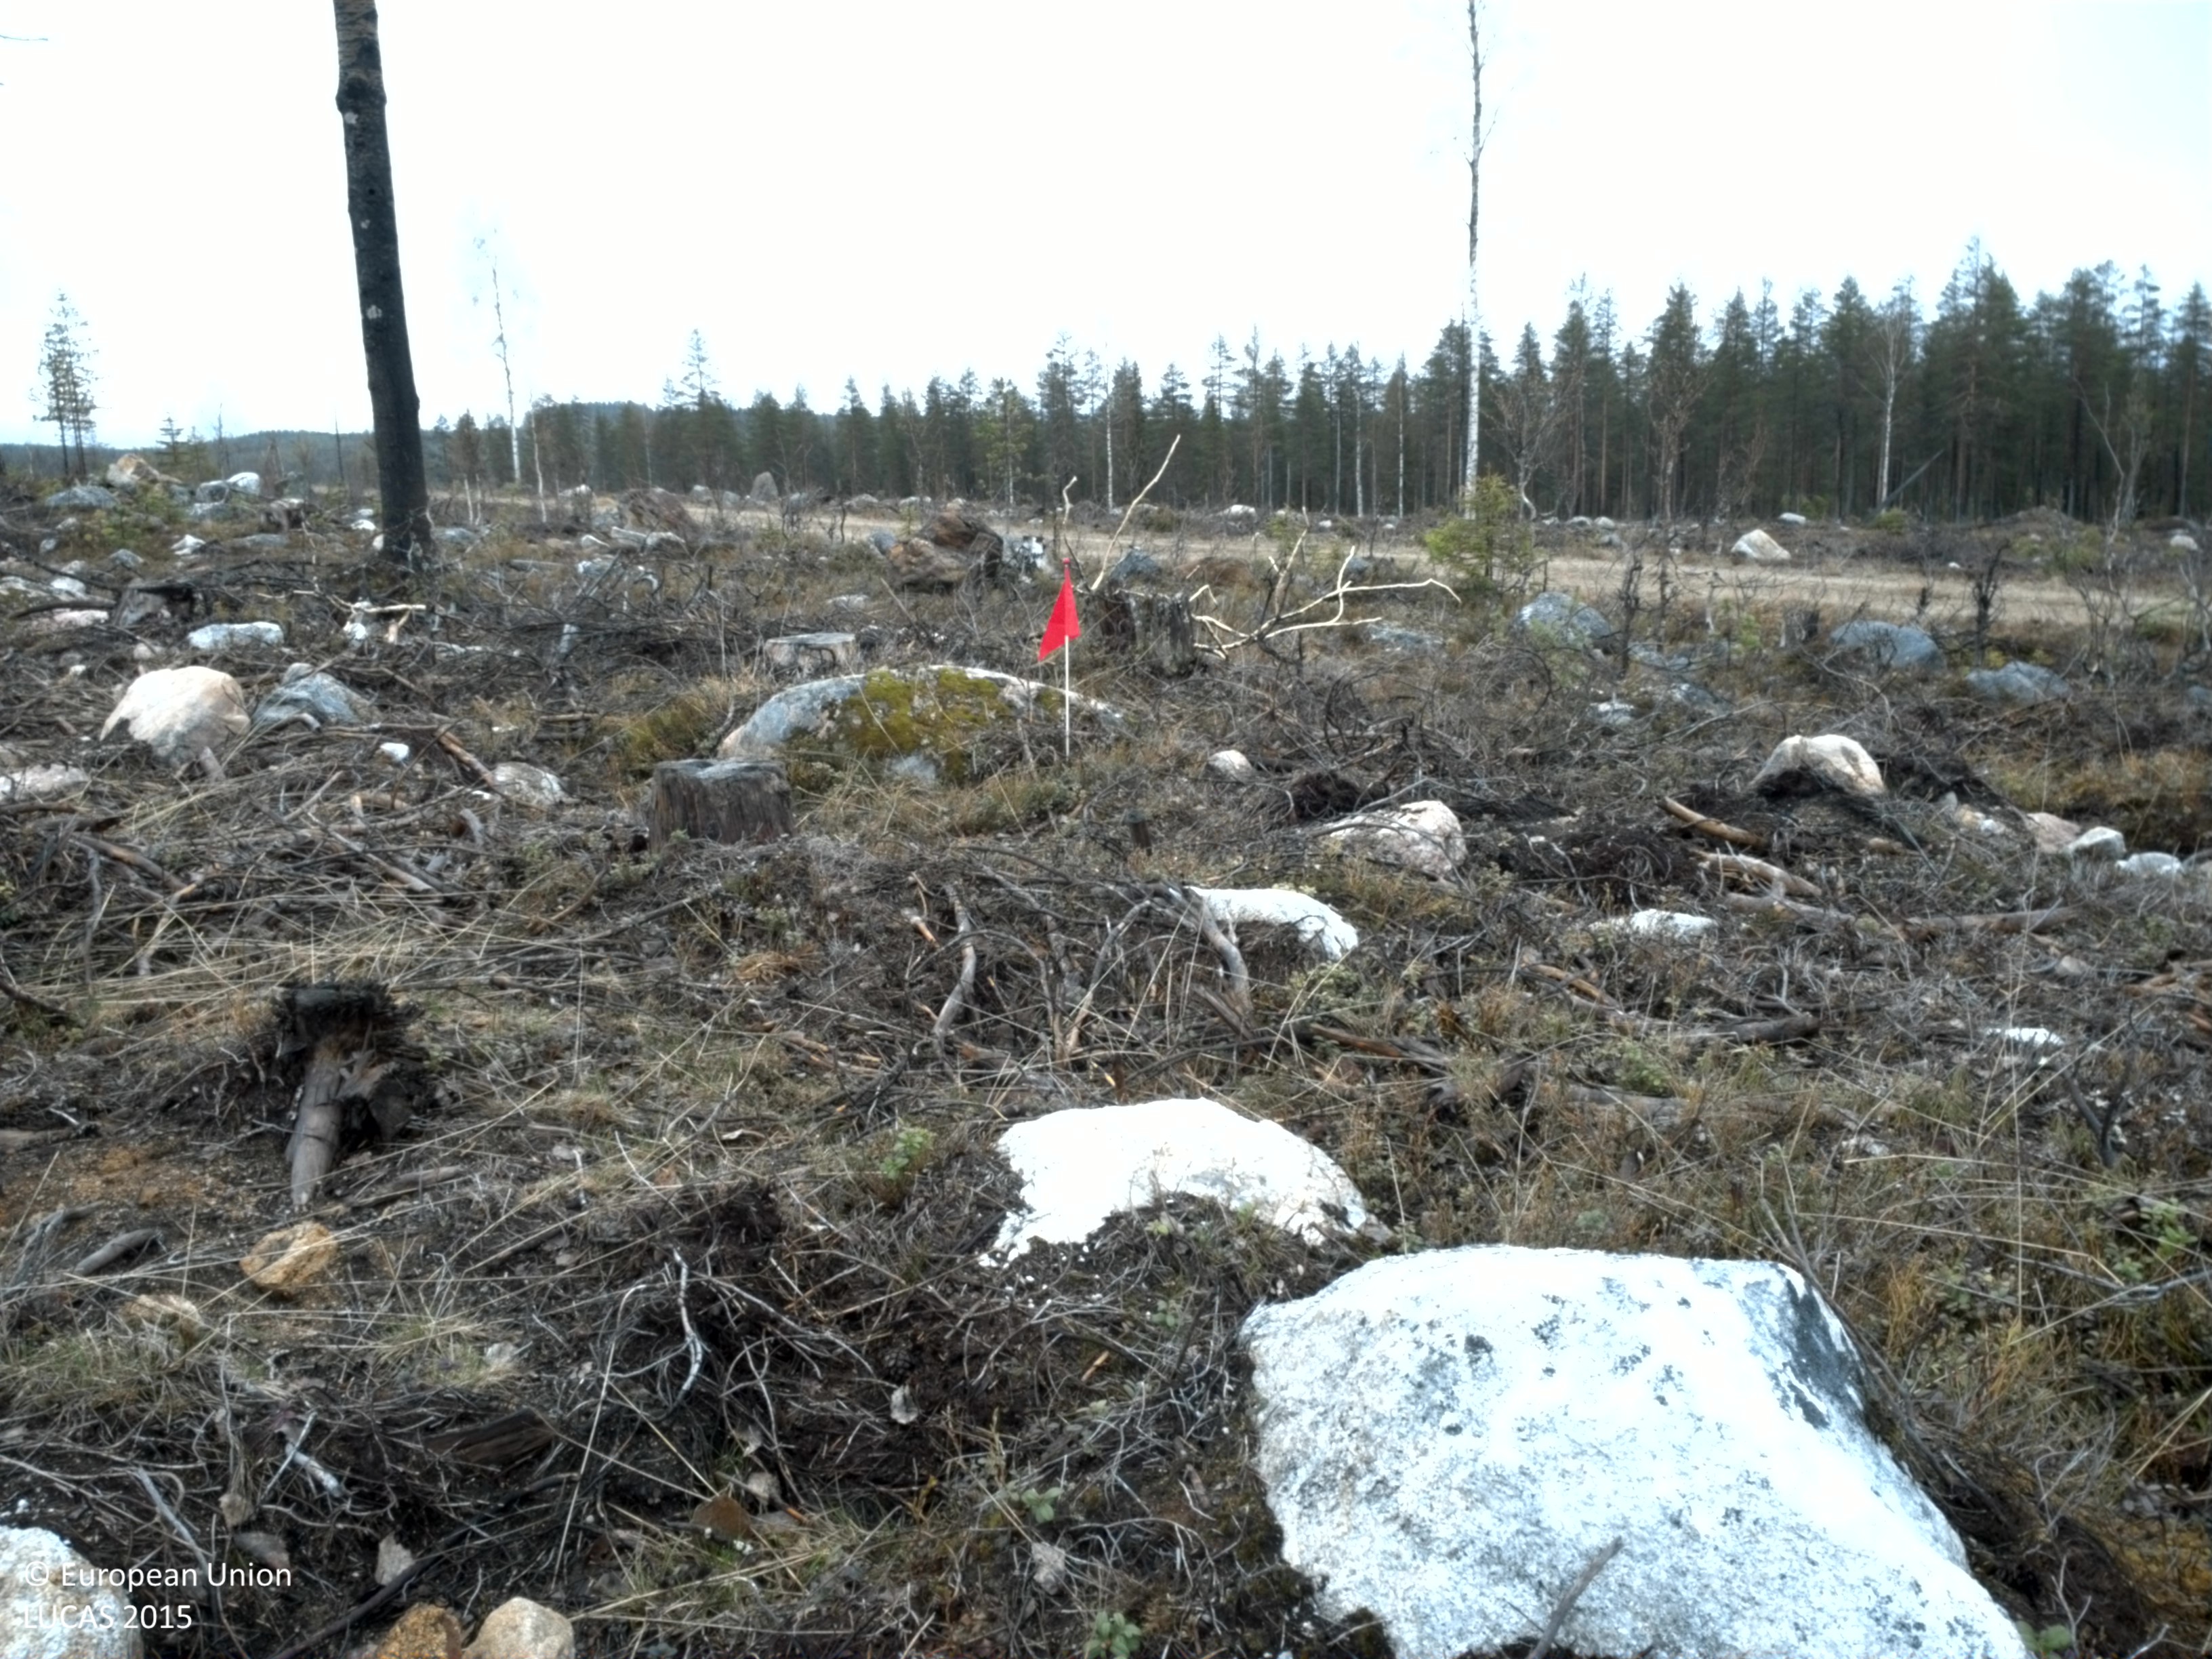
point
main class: Shrubland
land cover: Shrubland with sparse tree cover
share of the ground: > 75 %
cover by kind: shrubs 90 %, coniferous forest trees 5 %, consolidated bare surface 5 %
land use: Forestry
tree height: < 5 m
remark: Clear cut
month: May
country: SE
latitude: 66.2790
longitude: 23.3286
